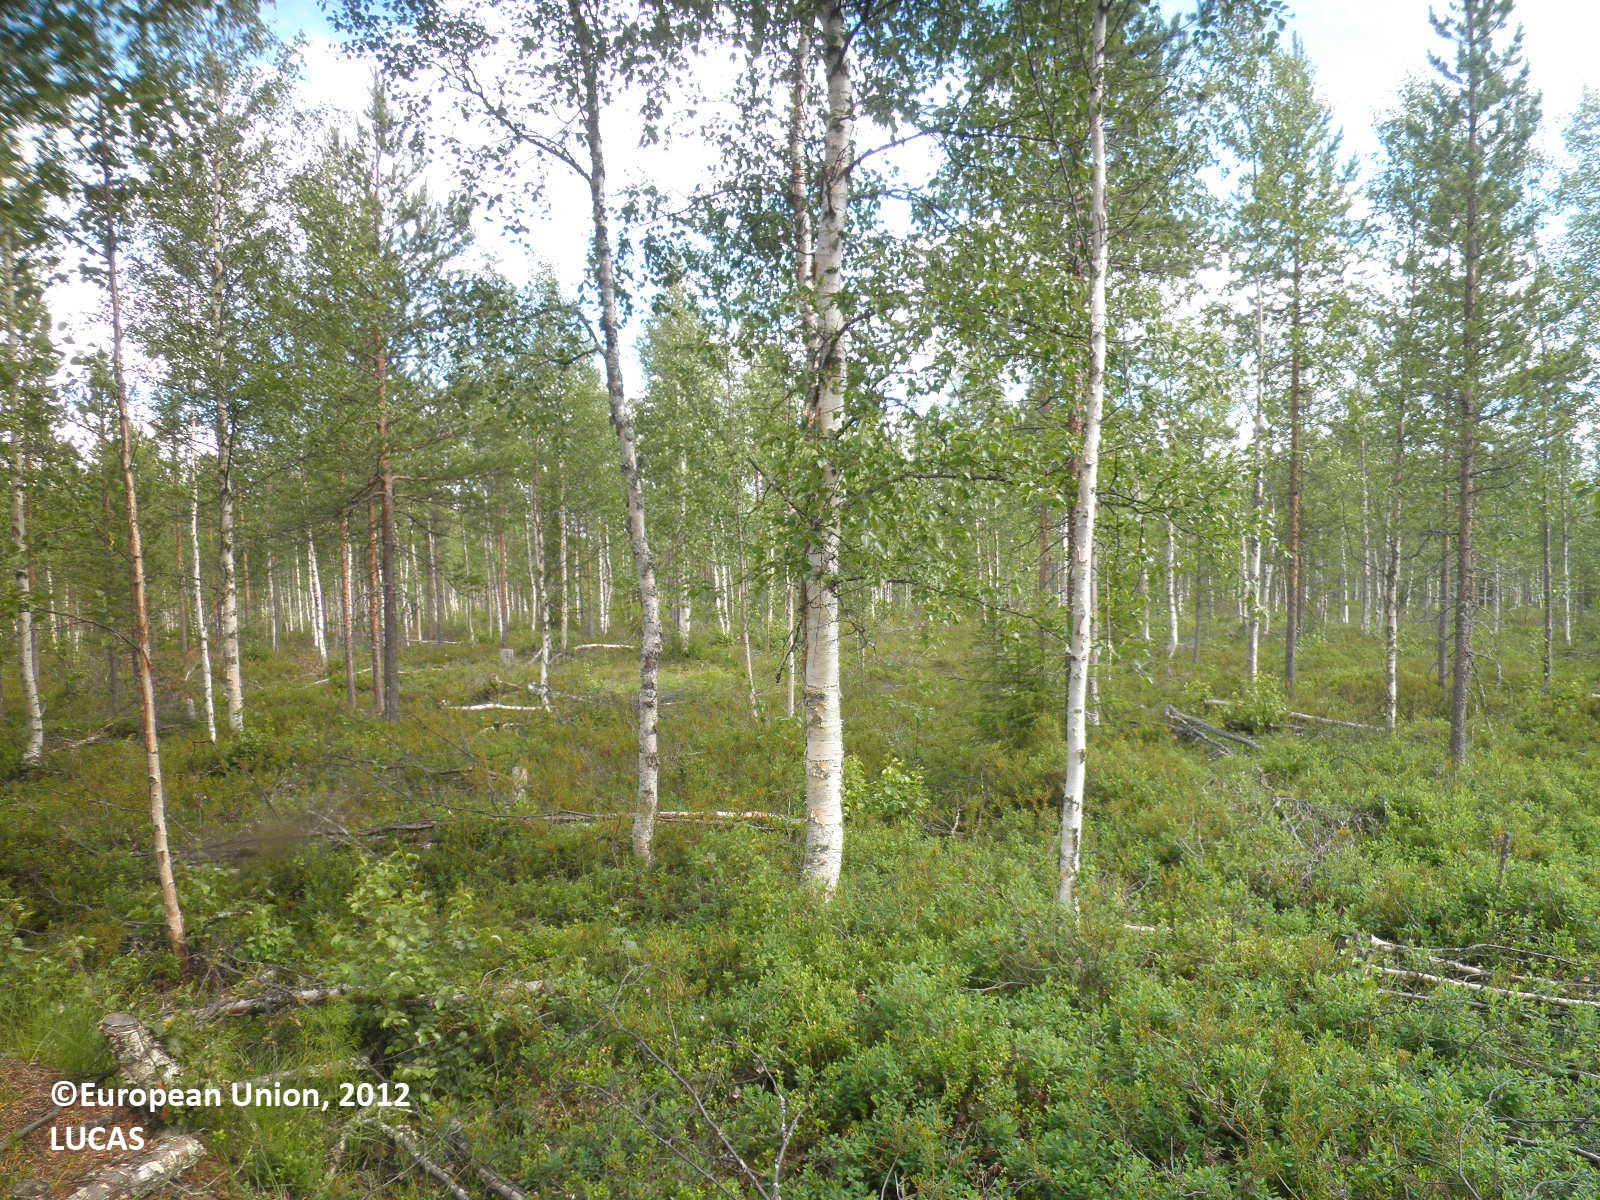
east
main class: Woodland
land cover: Pine dominated mixed woodland
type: boreal forest
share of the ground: 25 - 50 %
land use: Forestry
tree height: > 5 m
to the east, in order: Pine dominated mixed woodland; Ditches and canals; Pine dominated mixed woodland; Pine dominated coniferous woodland
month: July
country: FI
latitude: 67.4515
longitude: 26.8359
